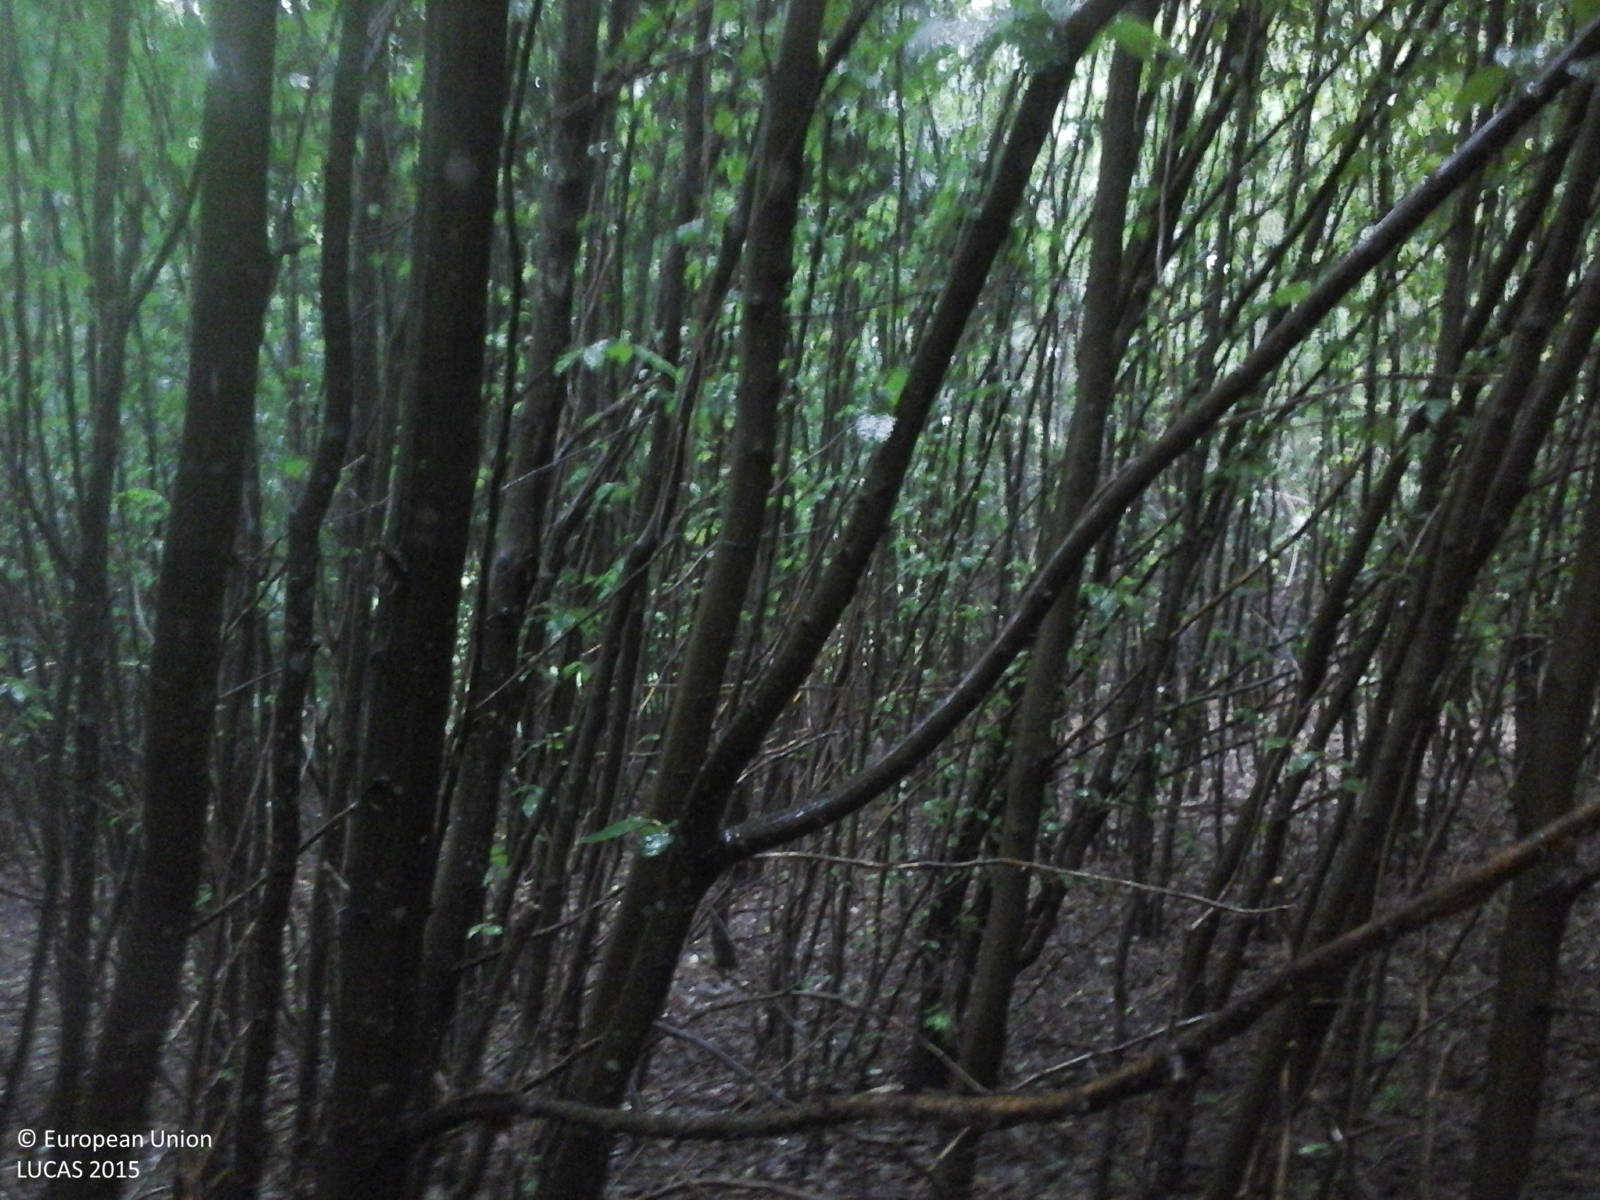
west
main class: Woodland
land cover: Broadleaved woodland
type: beech forest
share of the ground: > 75 %
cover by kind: broadleaved forest trees 100 %
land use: Forestry
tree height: > 5 m
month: May
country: RO
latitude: 45.8070
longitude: 25.3219
